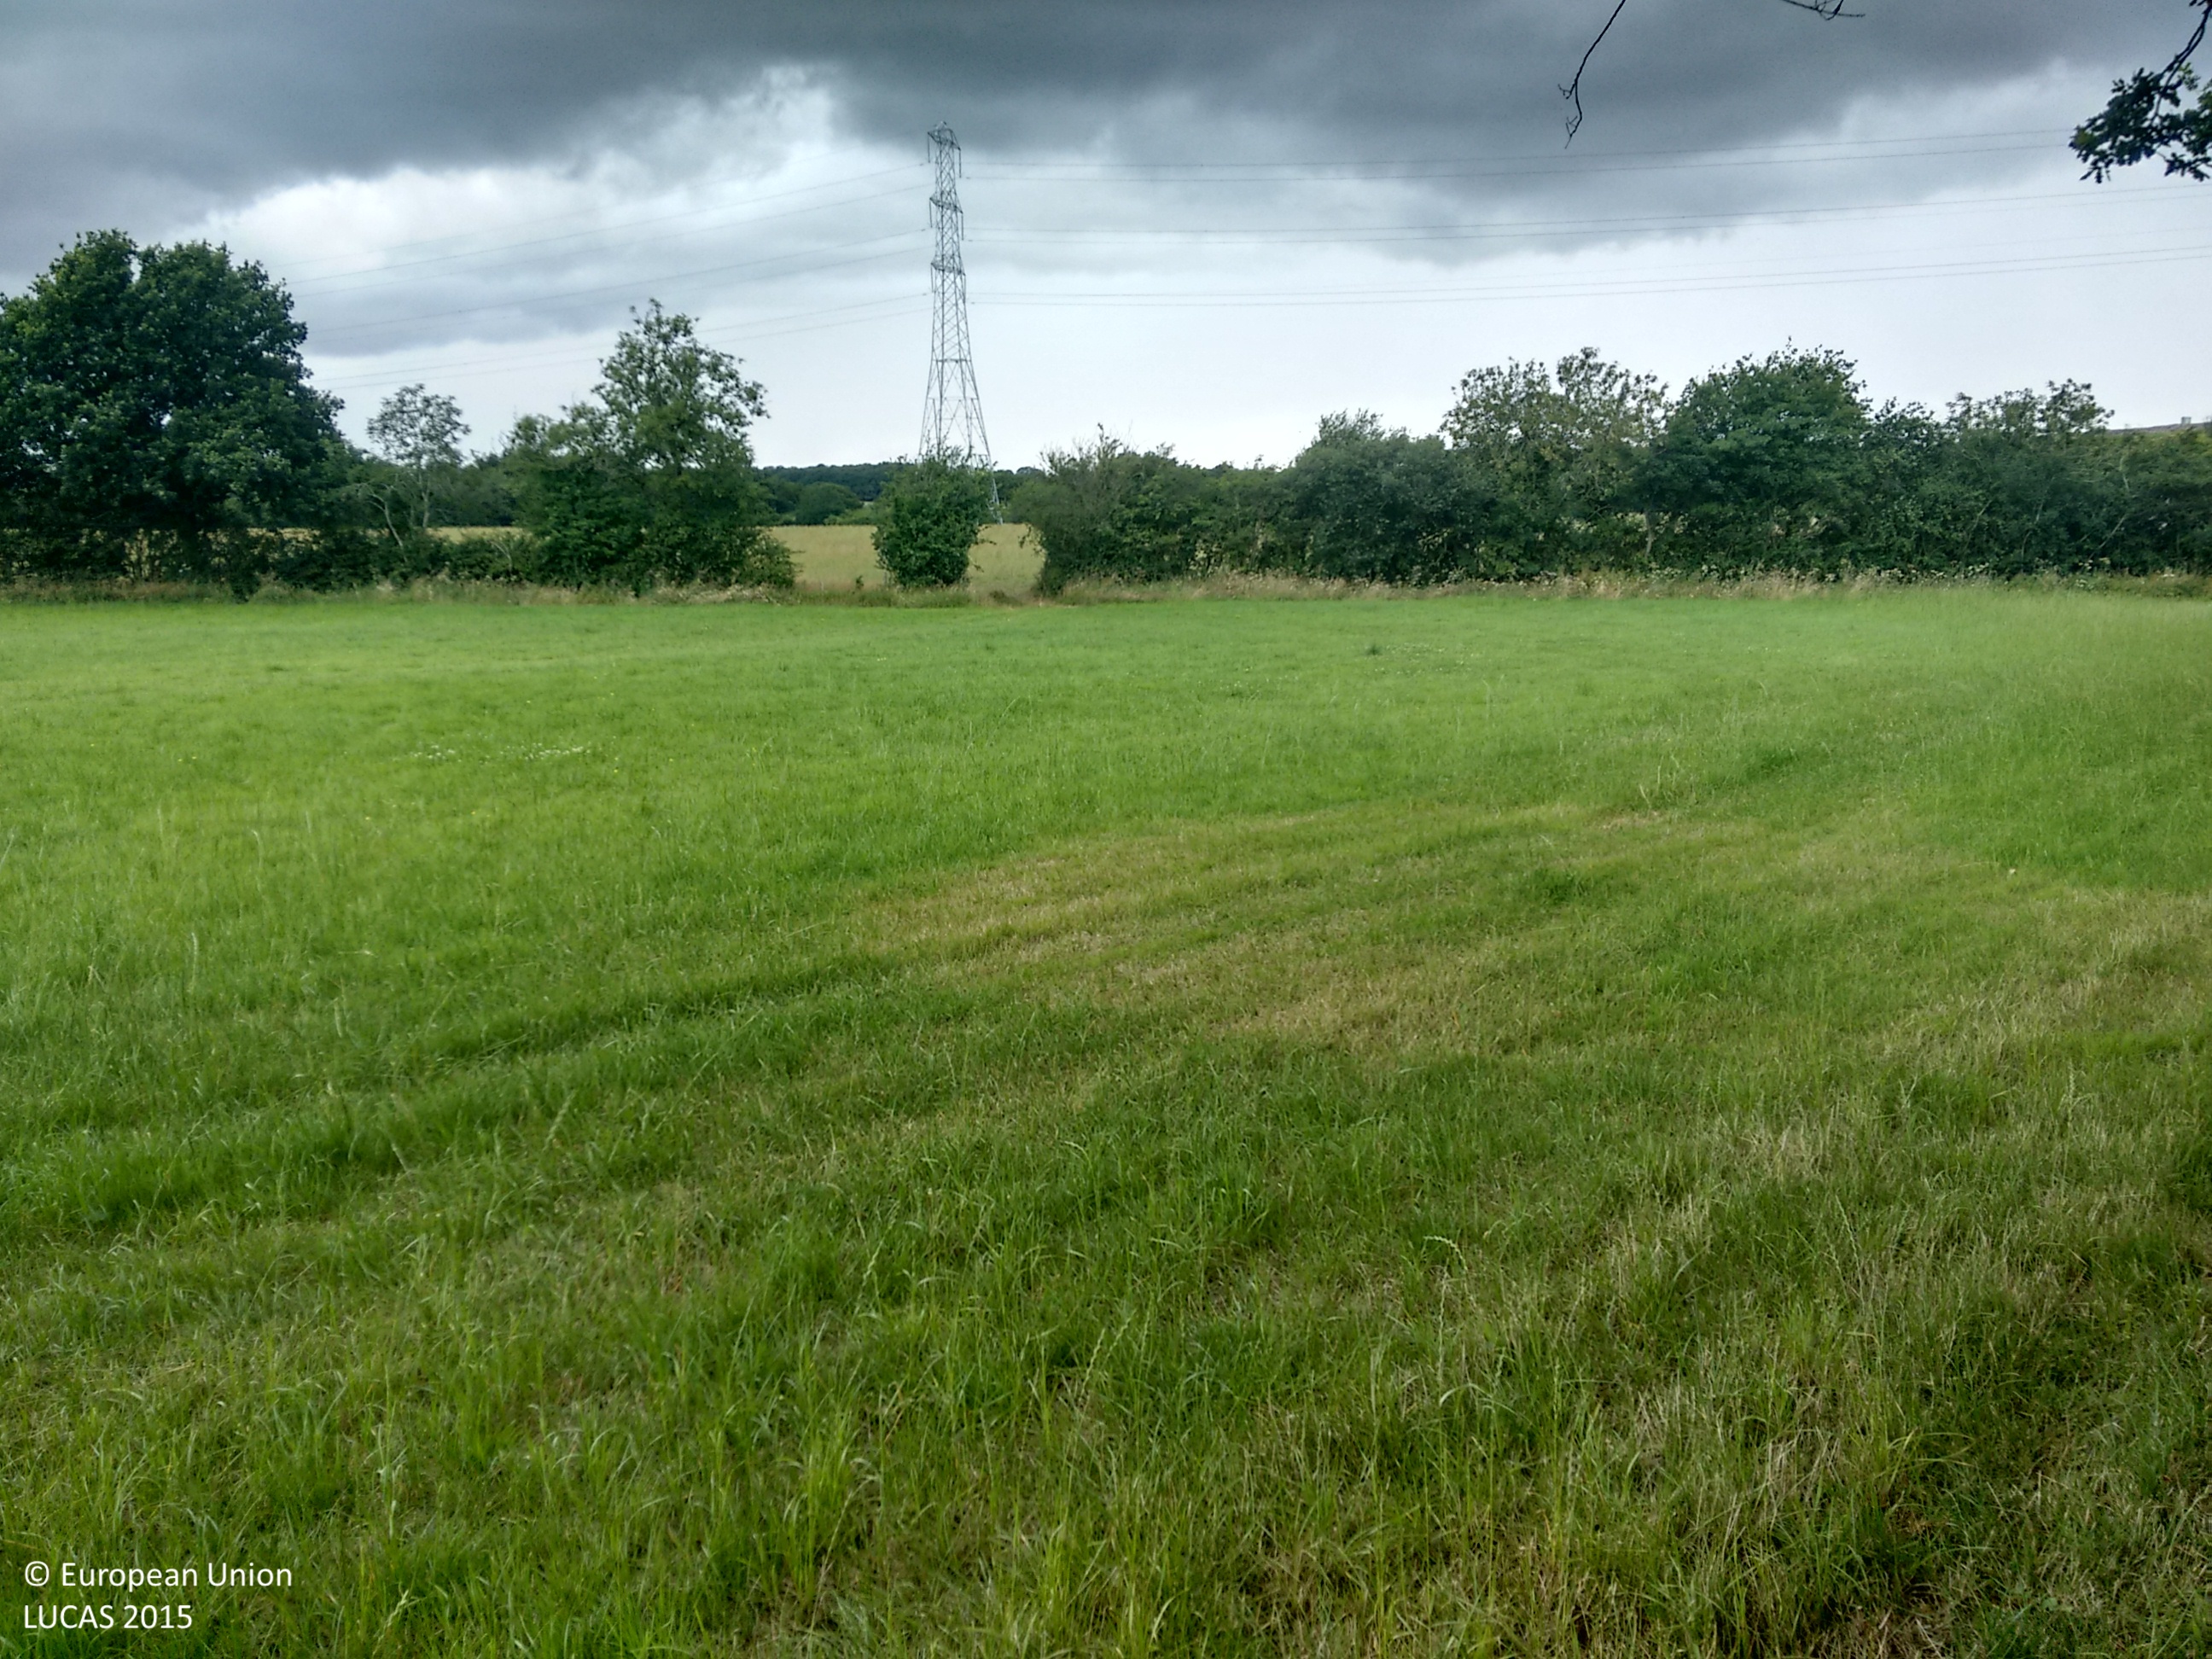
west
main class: Woodland
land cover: Broadleaved woodland
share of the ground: > 75 %
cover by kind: broadleaved forest trees 100 %
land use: Agriculture (excluding fallow land and kitchen gardens)
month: July
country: GB
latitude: 51.5192
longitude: -2.4451
